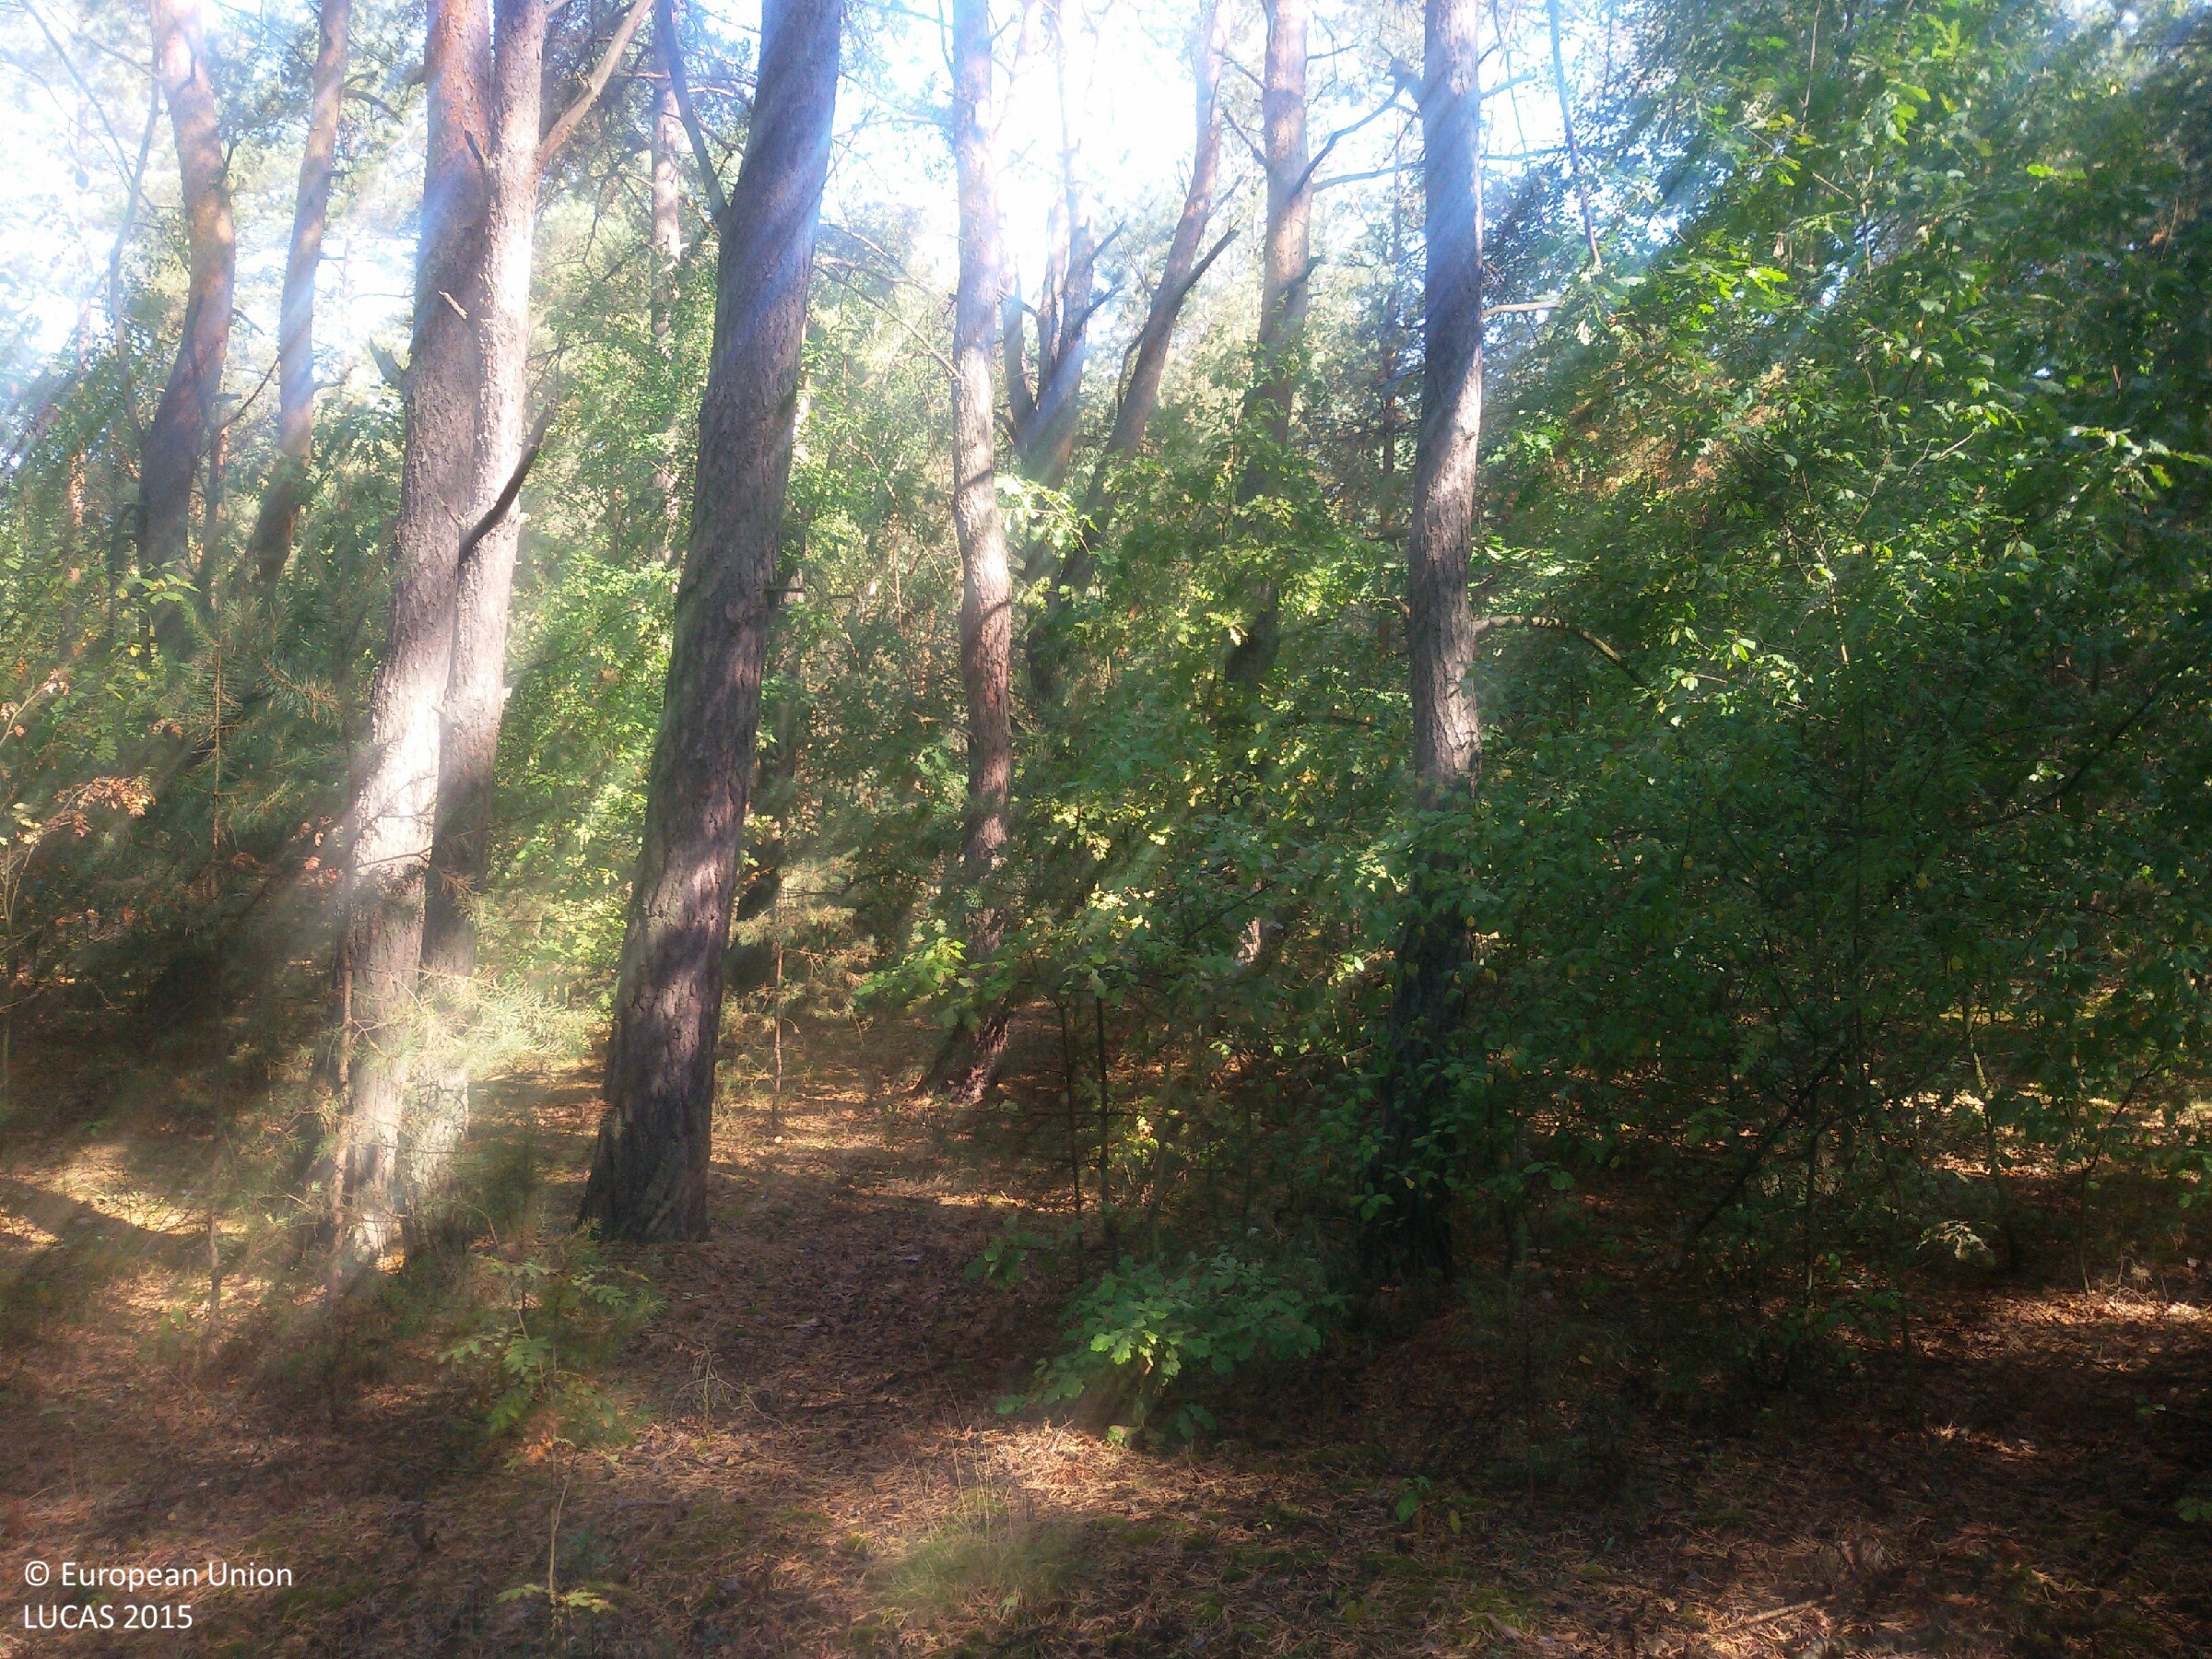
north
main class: Woodland
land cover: Pine dominated coniferous woodland
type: hemiboreal forest and nemoral coniferous forest and mixed broadleaved-coniferous forest
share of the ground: > 75 %
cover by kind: coniferous forest trees 80 %, herbaceous plants 10 %, broadleaved forest trees 5 %, shrubs 5 %
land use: Forestry
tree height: > 5 m
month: August
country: PL
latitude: 51.4681
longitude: 20.9702
